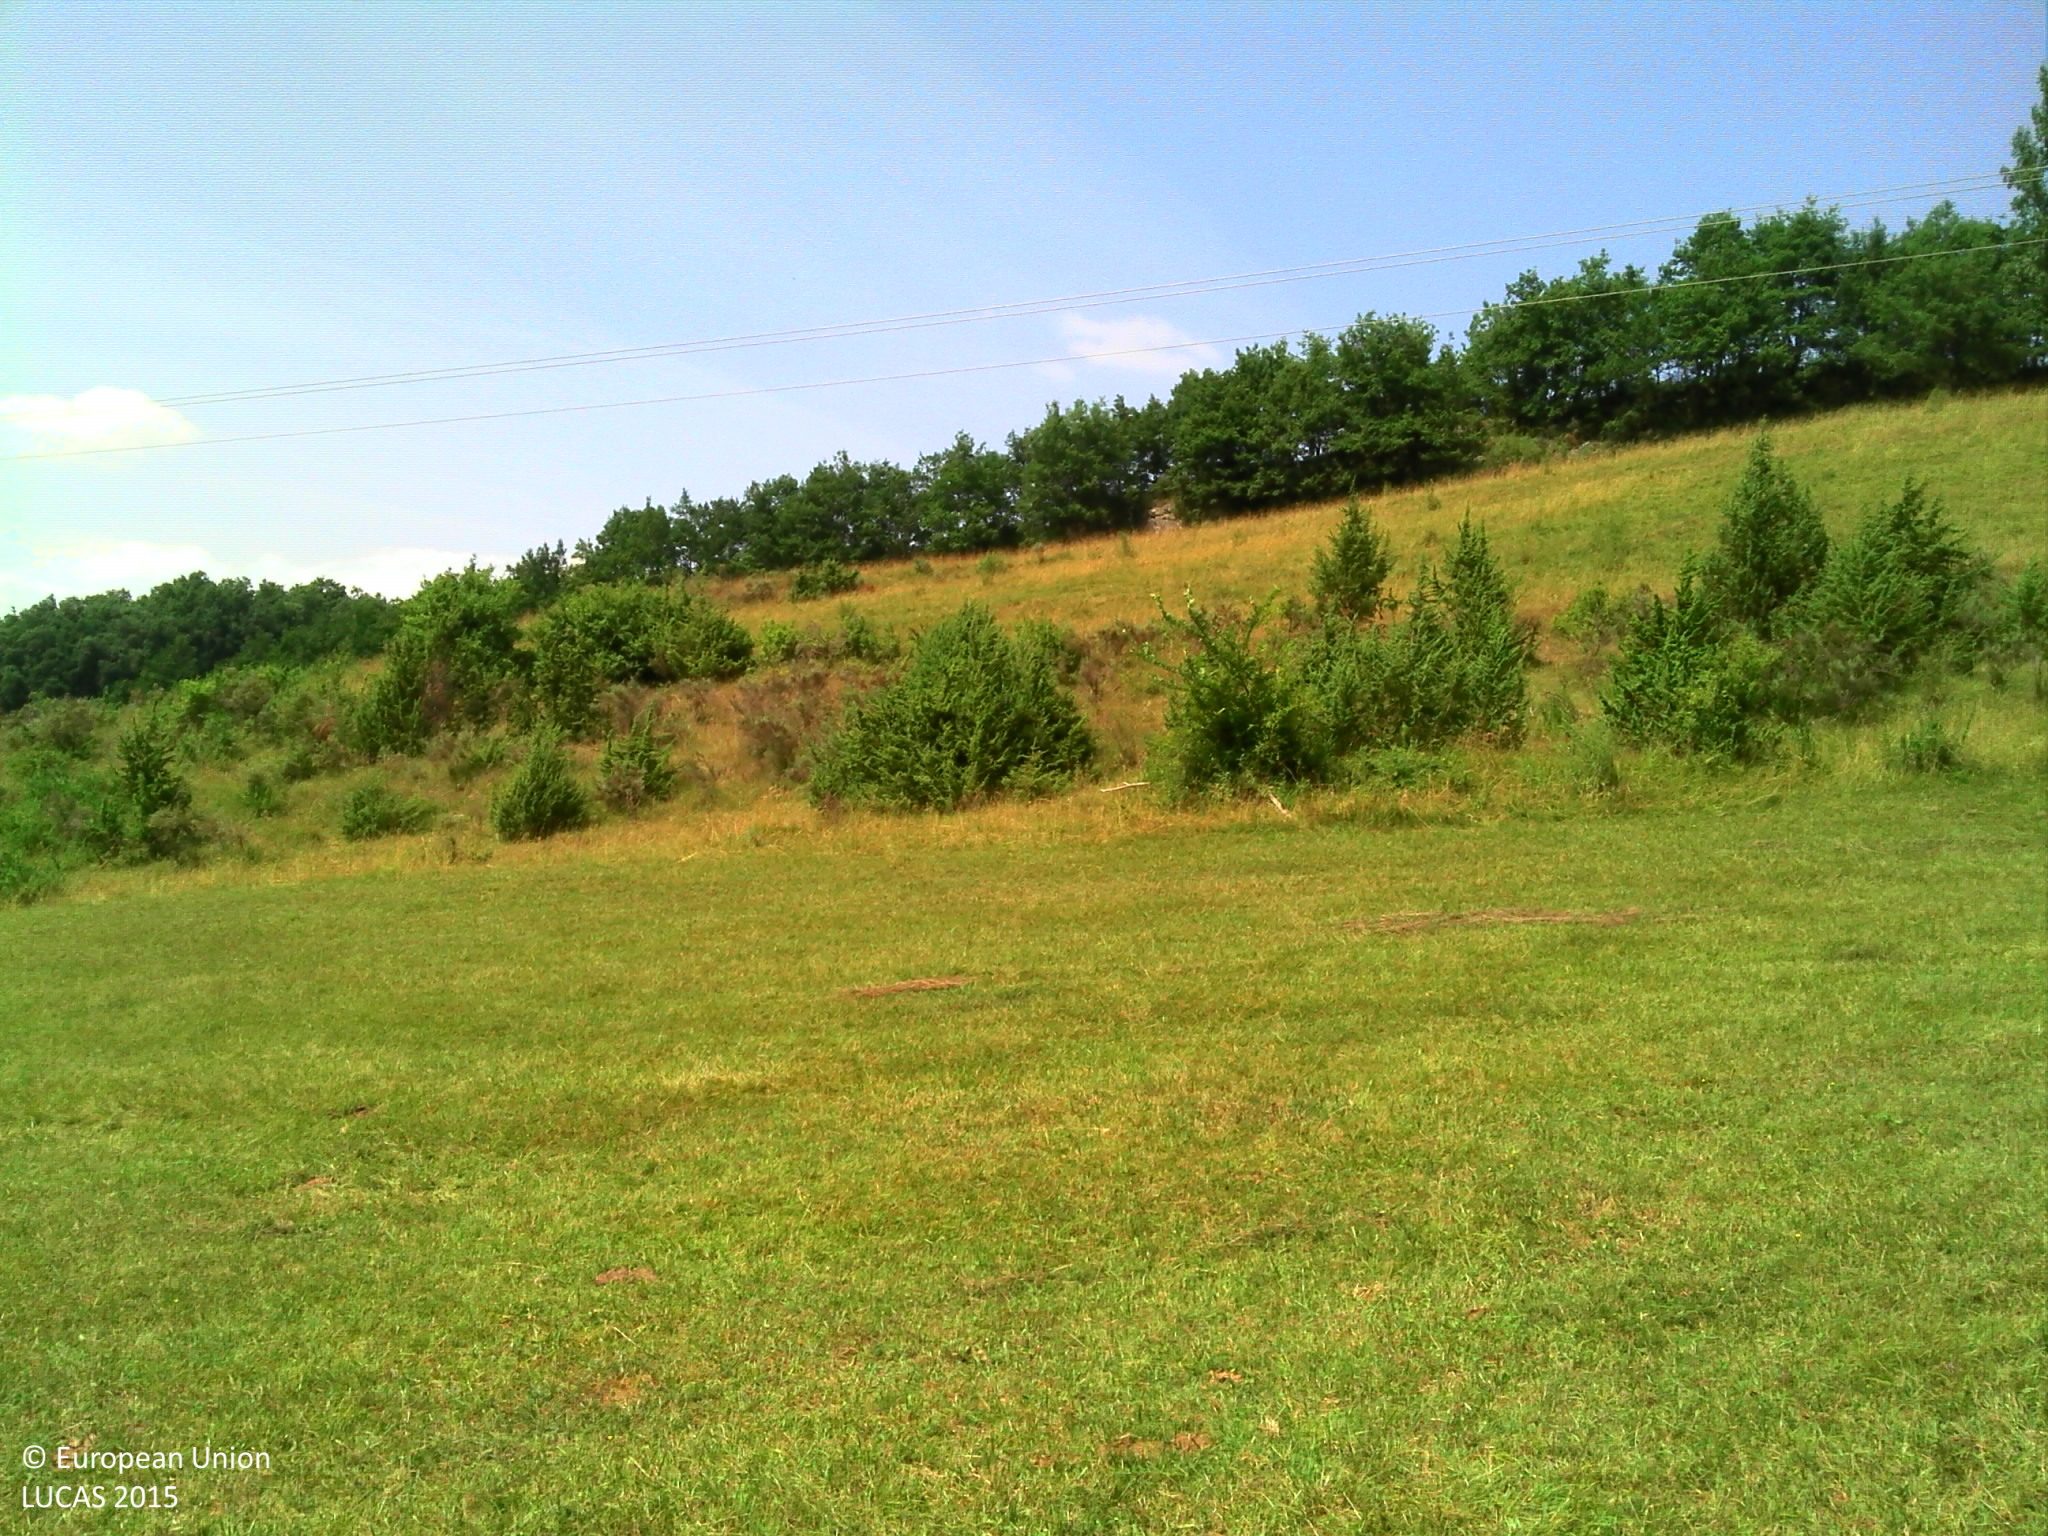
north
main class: Grassland
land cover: Grassland without tree/shrub cover
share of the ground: > 75 %
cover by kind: herbaceous plants 100 %
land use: Agriculture (excluding fallow land and kitchen gardens)
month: July
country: FR
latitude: 43.0878
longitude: 1.4187
